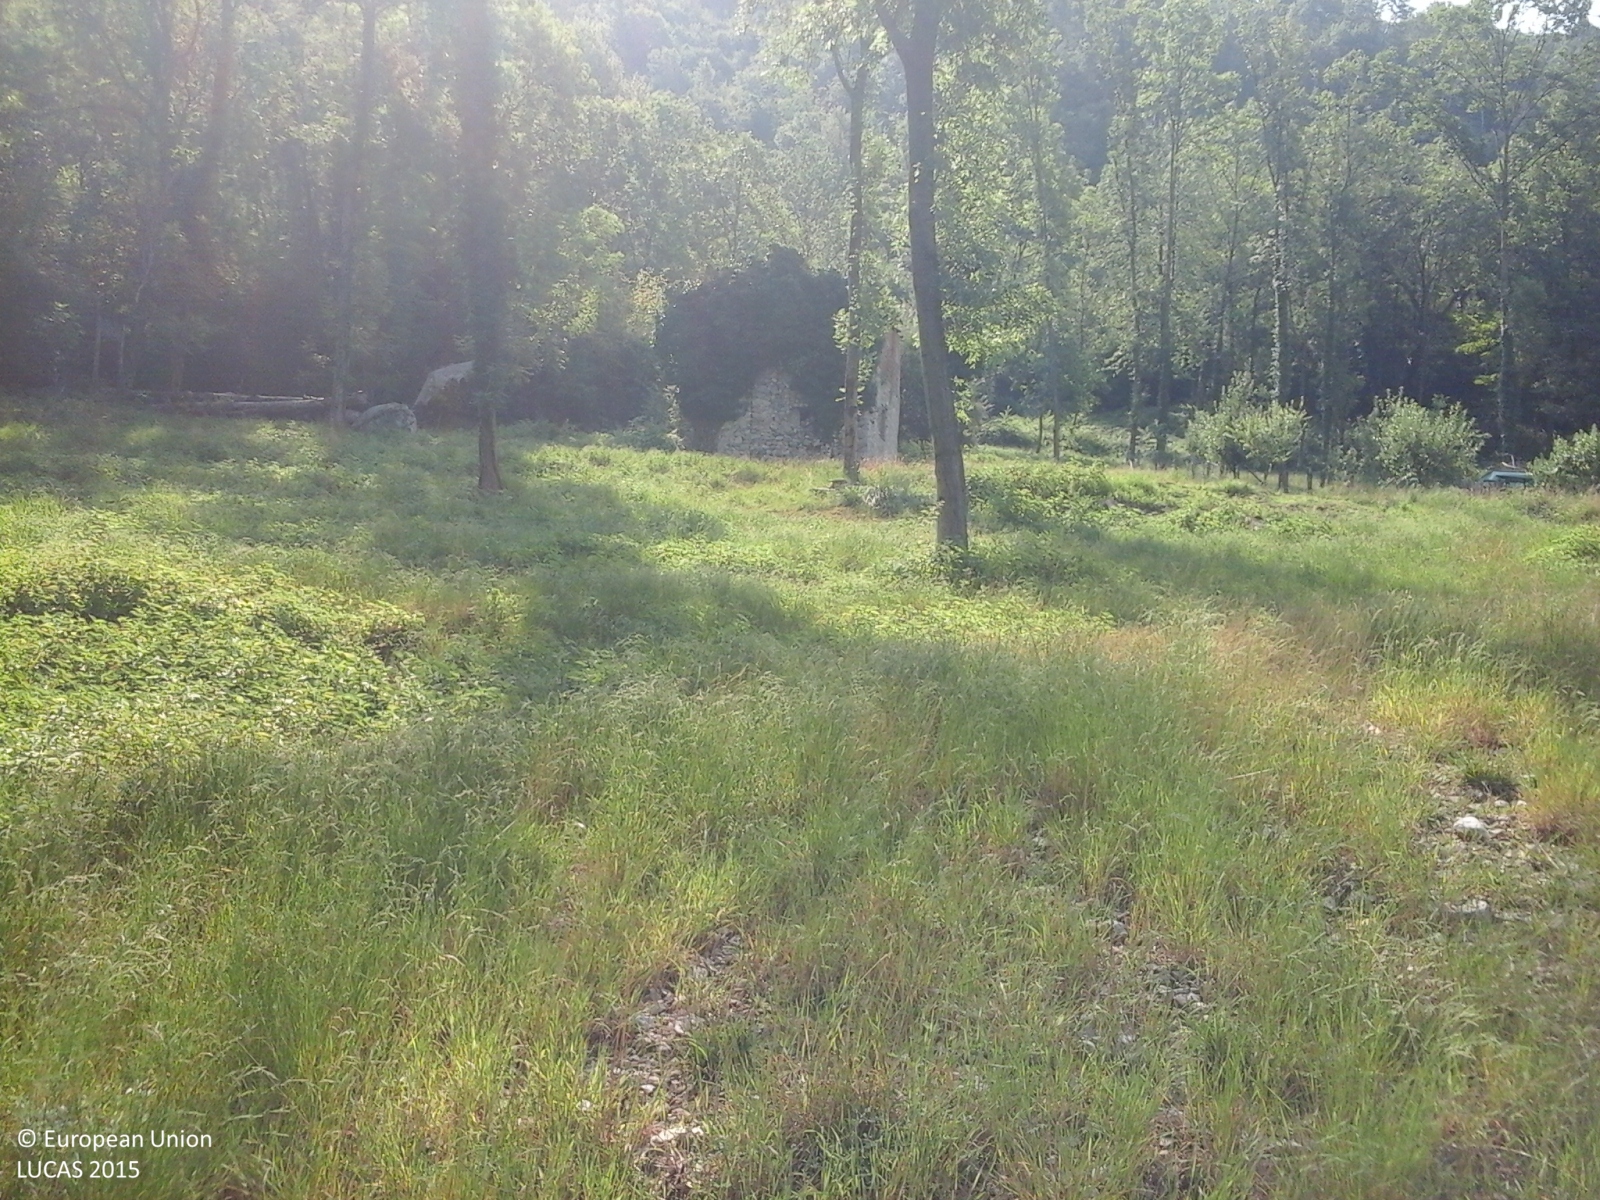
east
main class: Woodland
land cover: Broadleaved woodland
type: thermophilous deciduous forest
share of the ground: > 75 %
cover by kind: broadleaved forest trees 80 %, herbaceous plants 20 %
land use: Forestry
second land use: Amenities, museums, leisure
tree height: > 5 m
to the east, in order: Broadleaved woodland; Tracks; Broadleaved woodland
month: July
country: IT
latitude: 45.9469
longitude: 8.6990
